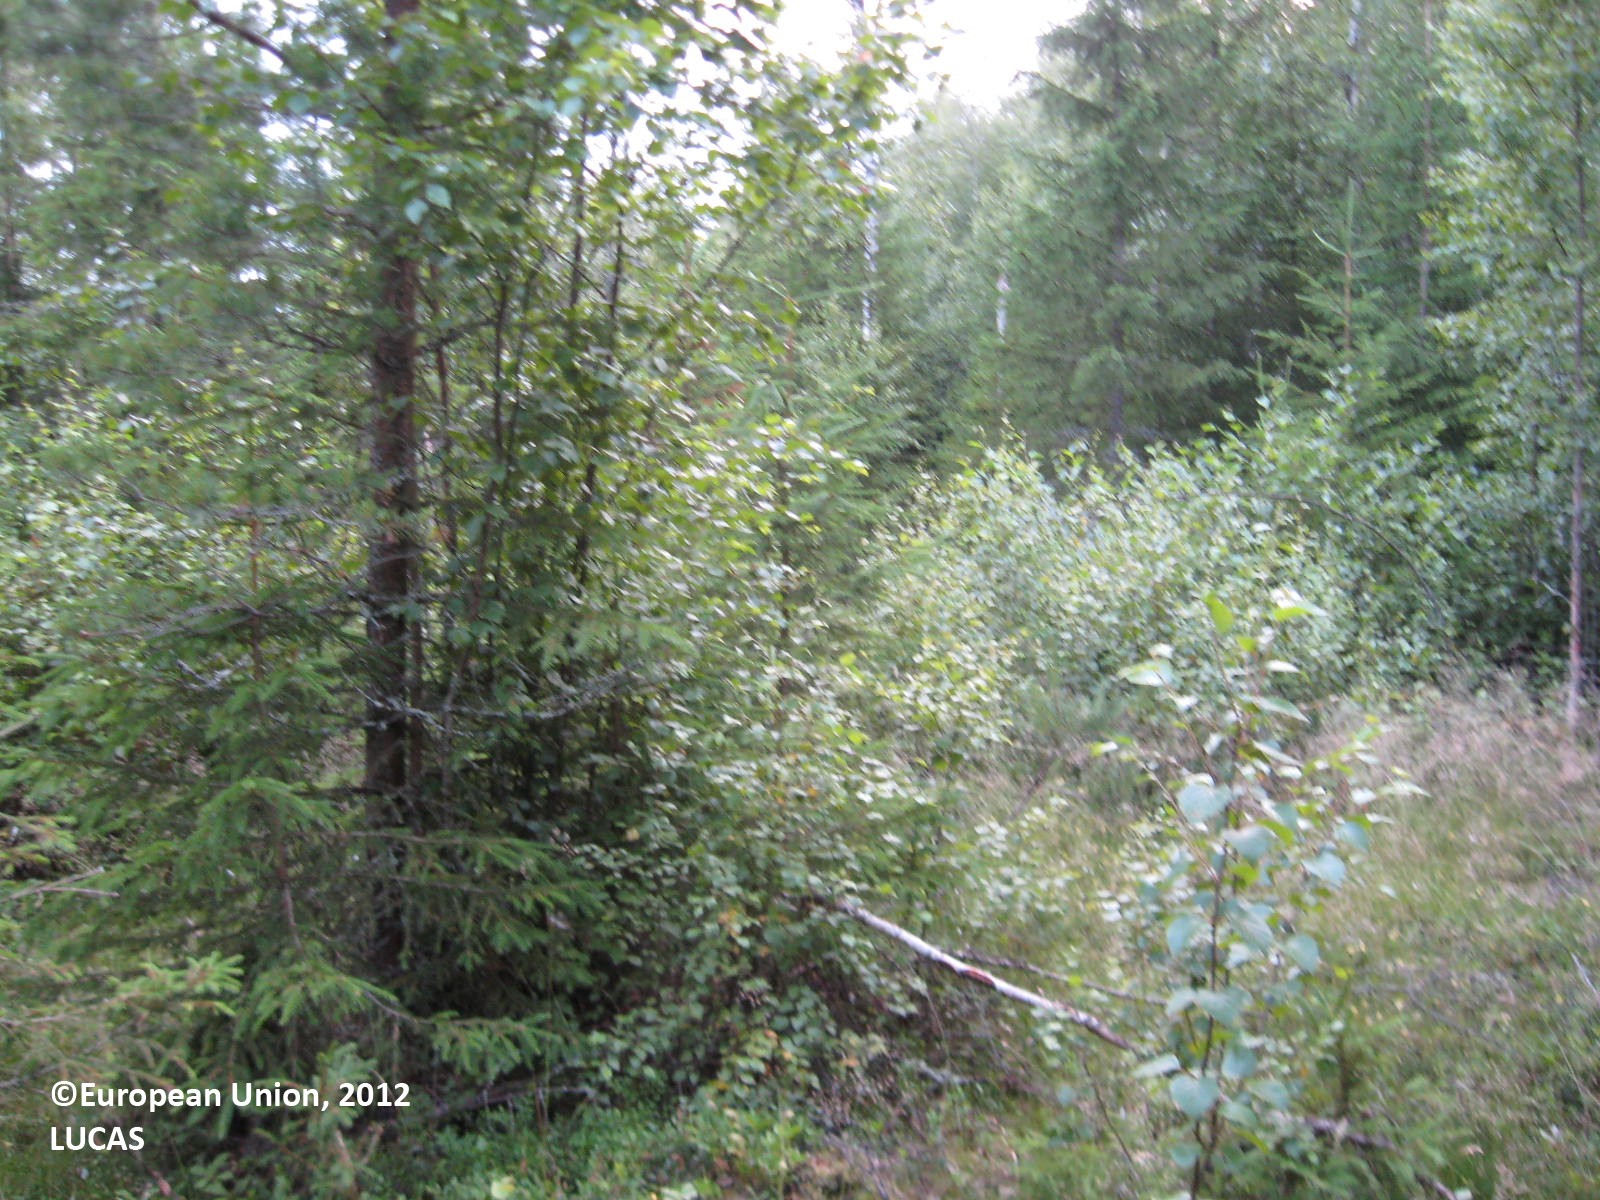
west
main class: Woodland
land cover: Other mixed woodland
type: boreal forest
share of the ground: > 75 %
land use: Forestry
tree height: > 5 m
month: July
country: FI
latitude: 62.3439
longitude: 21.3792
